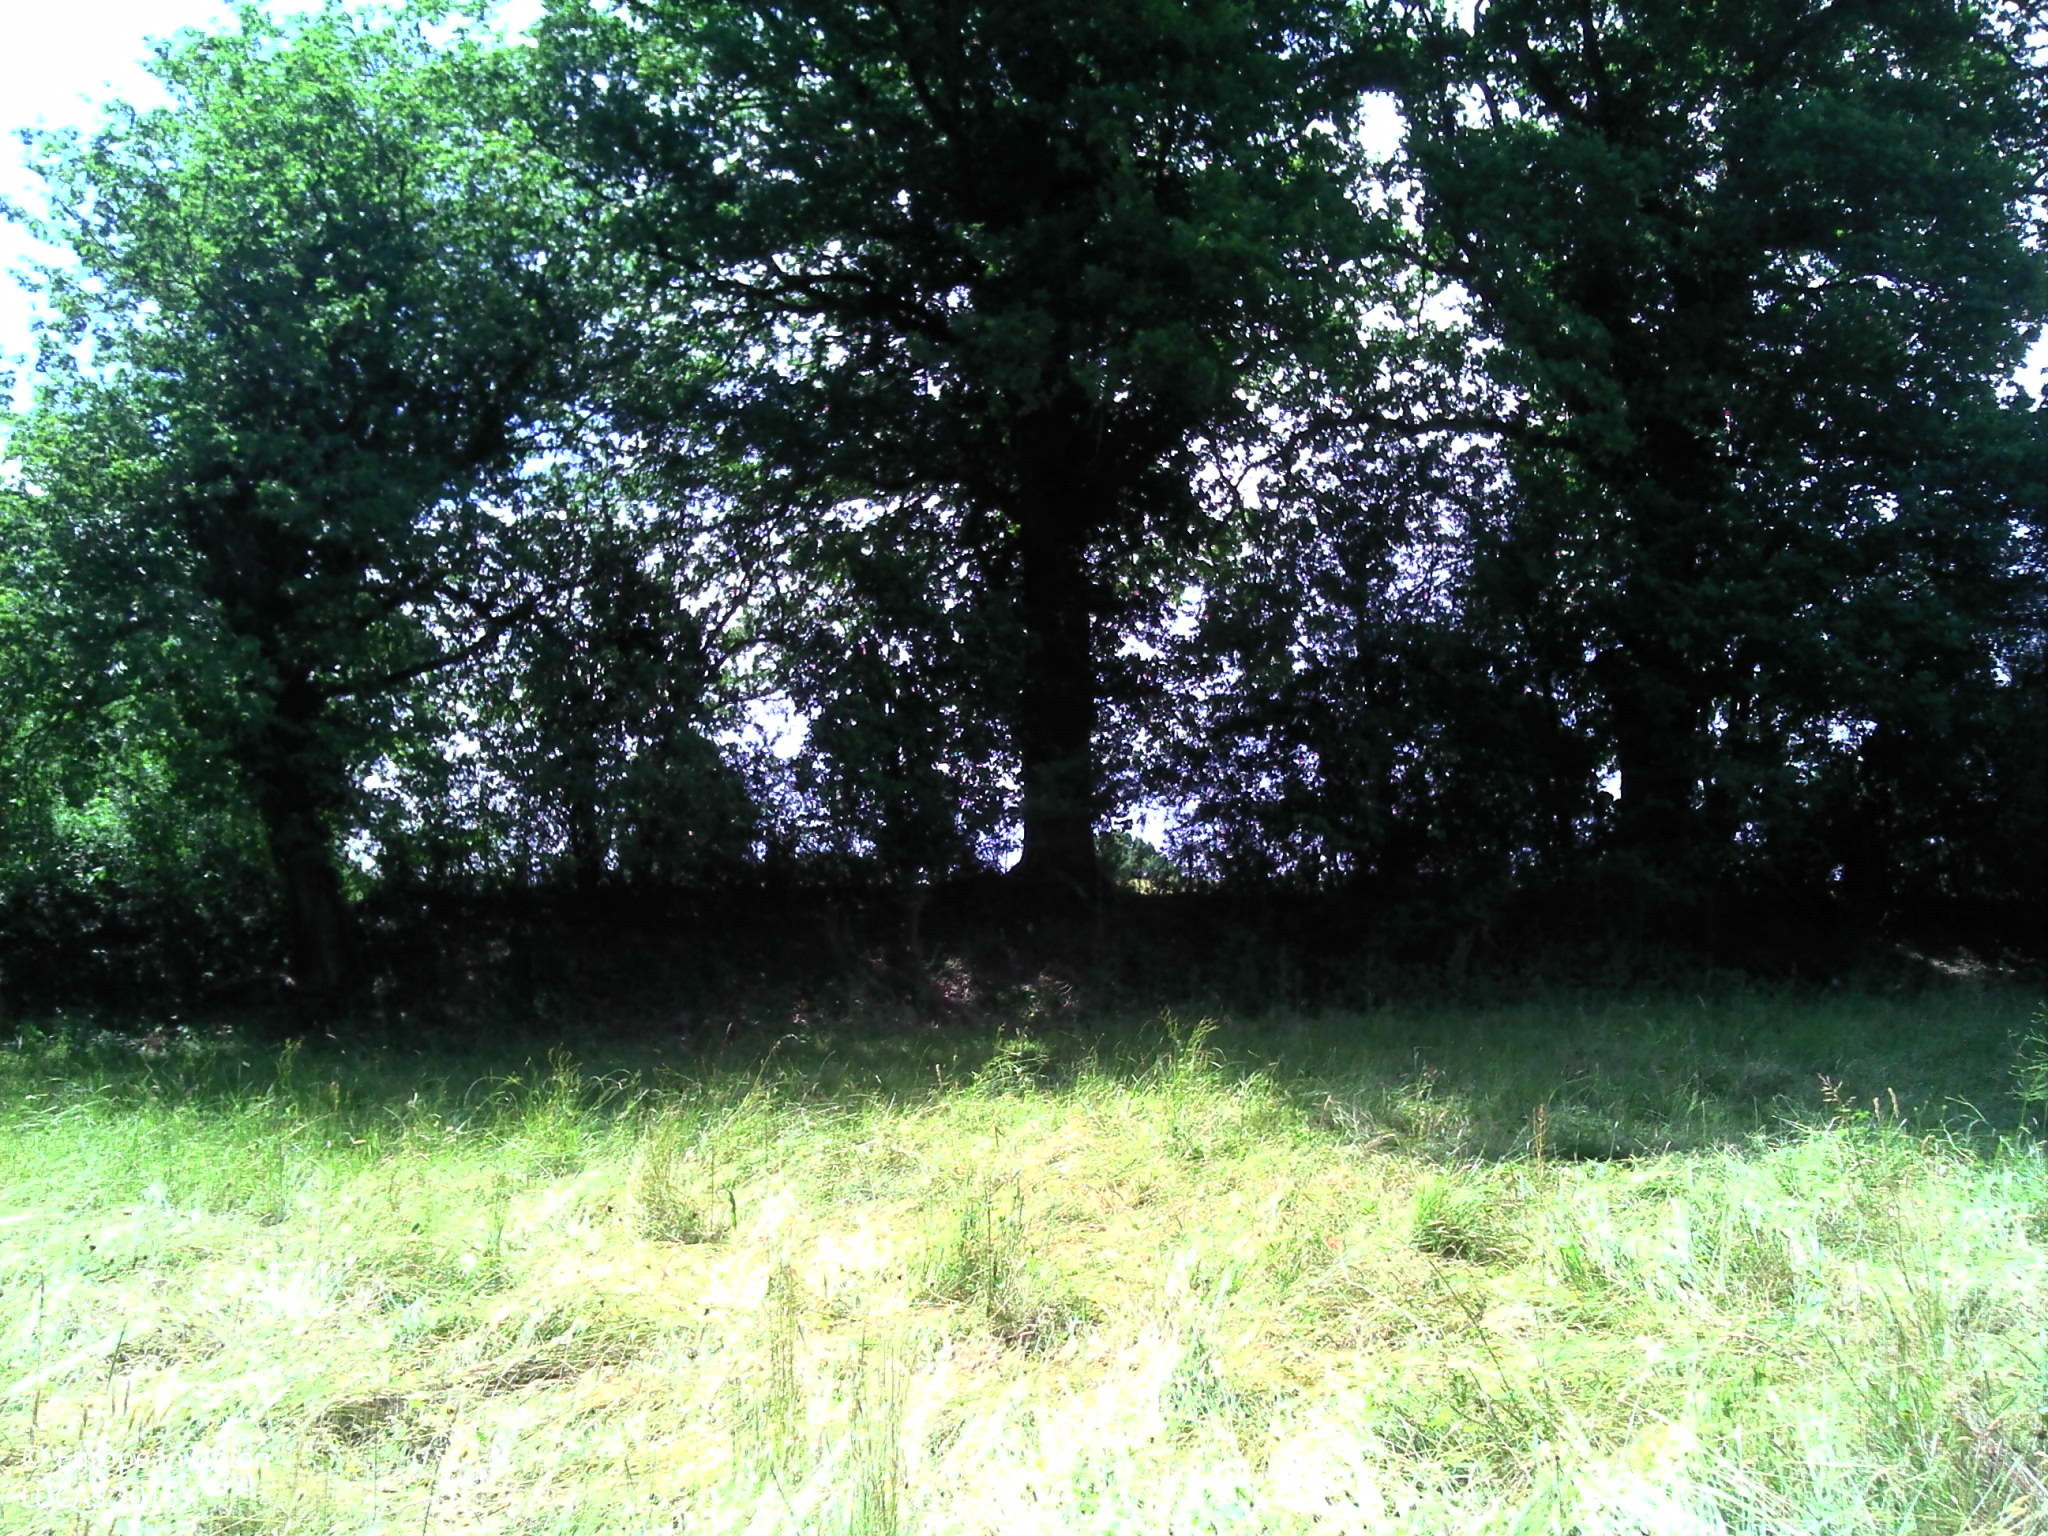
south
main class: Grassland
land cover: Grassland without tree/shrub cover
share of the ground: > 75 %
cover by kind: herbaceous plants 100 %
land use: Agriculture (excluding fallow land and kitchen gardens)
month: June
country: FR
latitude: 46.5164
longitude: 2.6836
